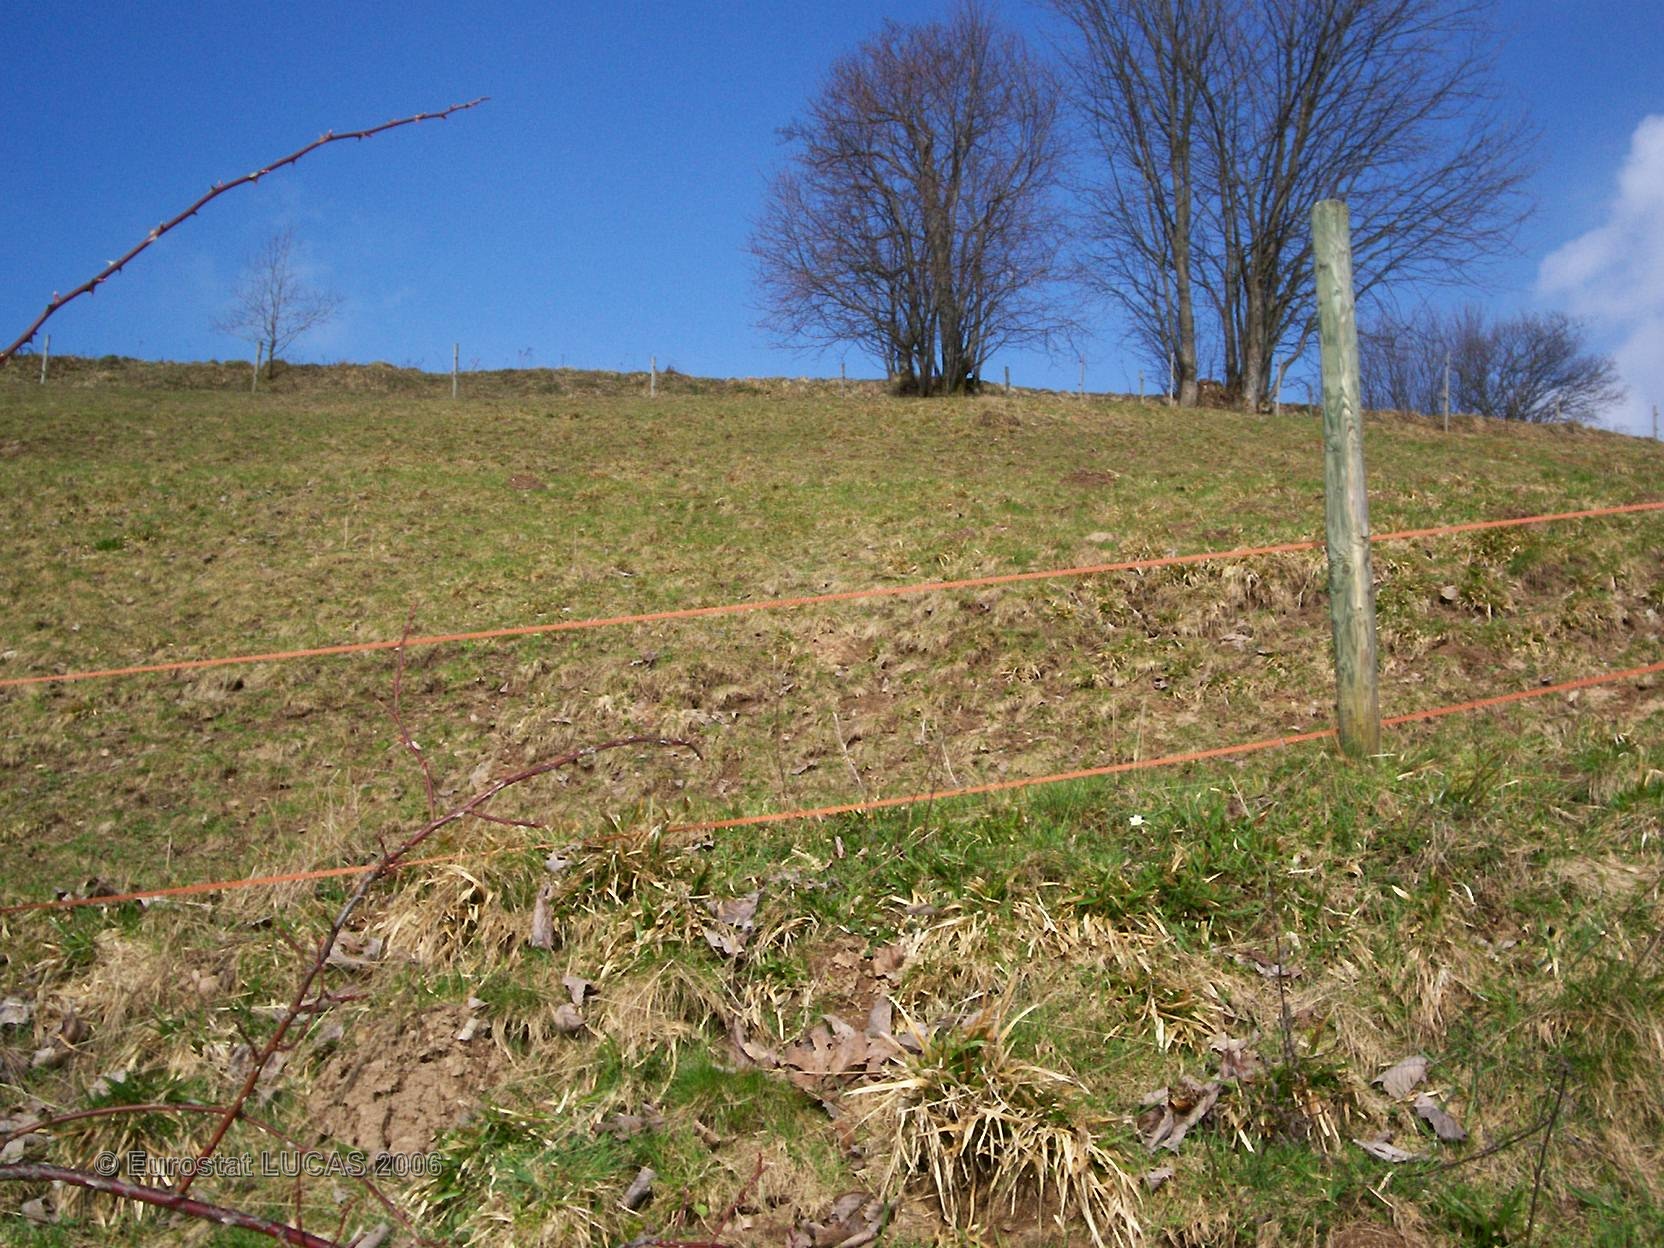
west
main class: Grassland
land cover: Grassland with sparse tree/shrub cover
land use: Agriculture (excluding fallow land and kitchen gardens)
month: April
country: FR
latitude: 48.0958
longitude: 7.1142
